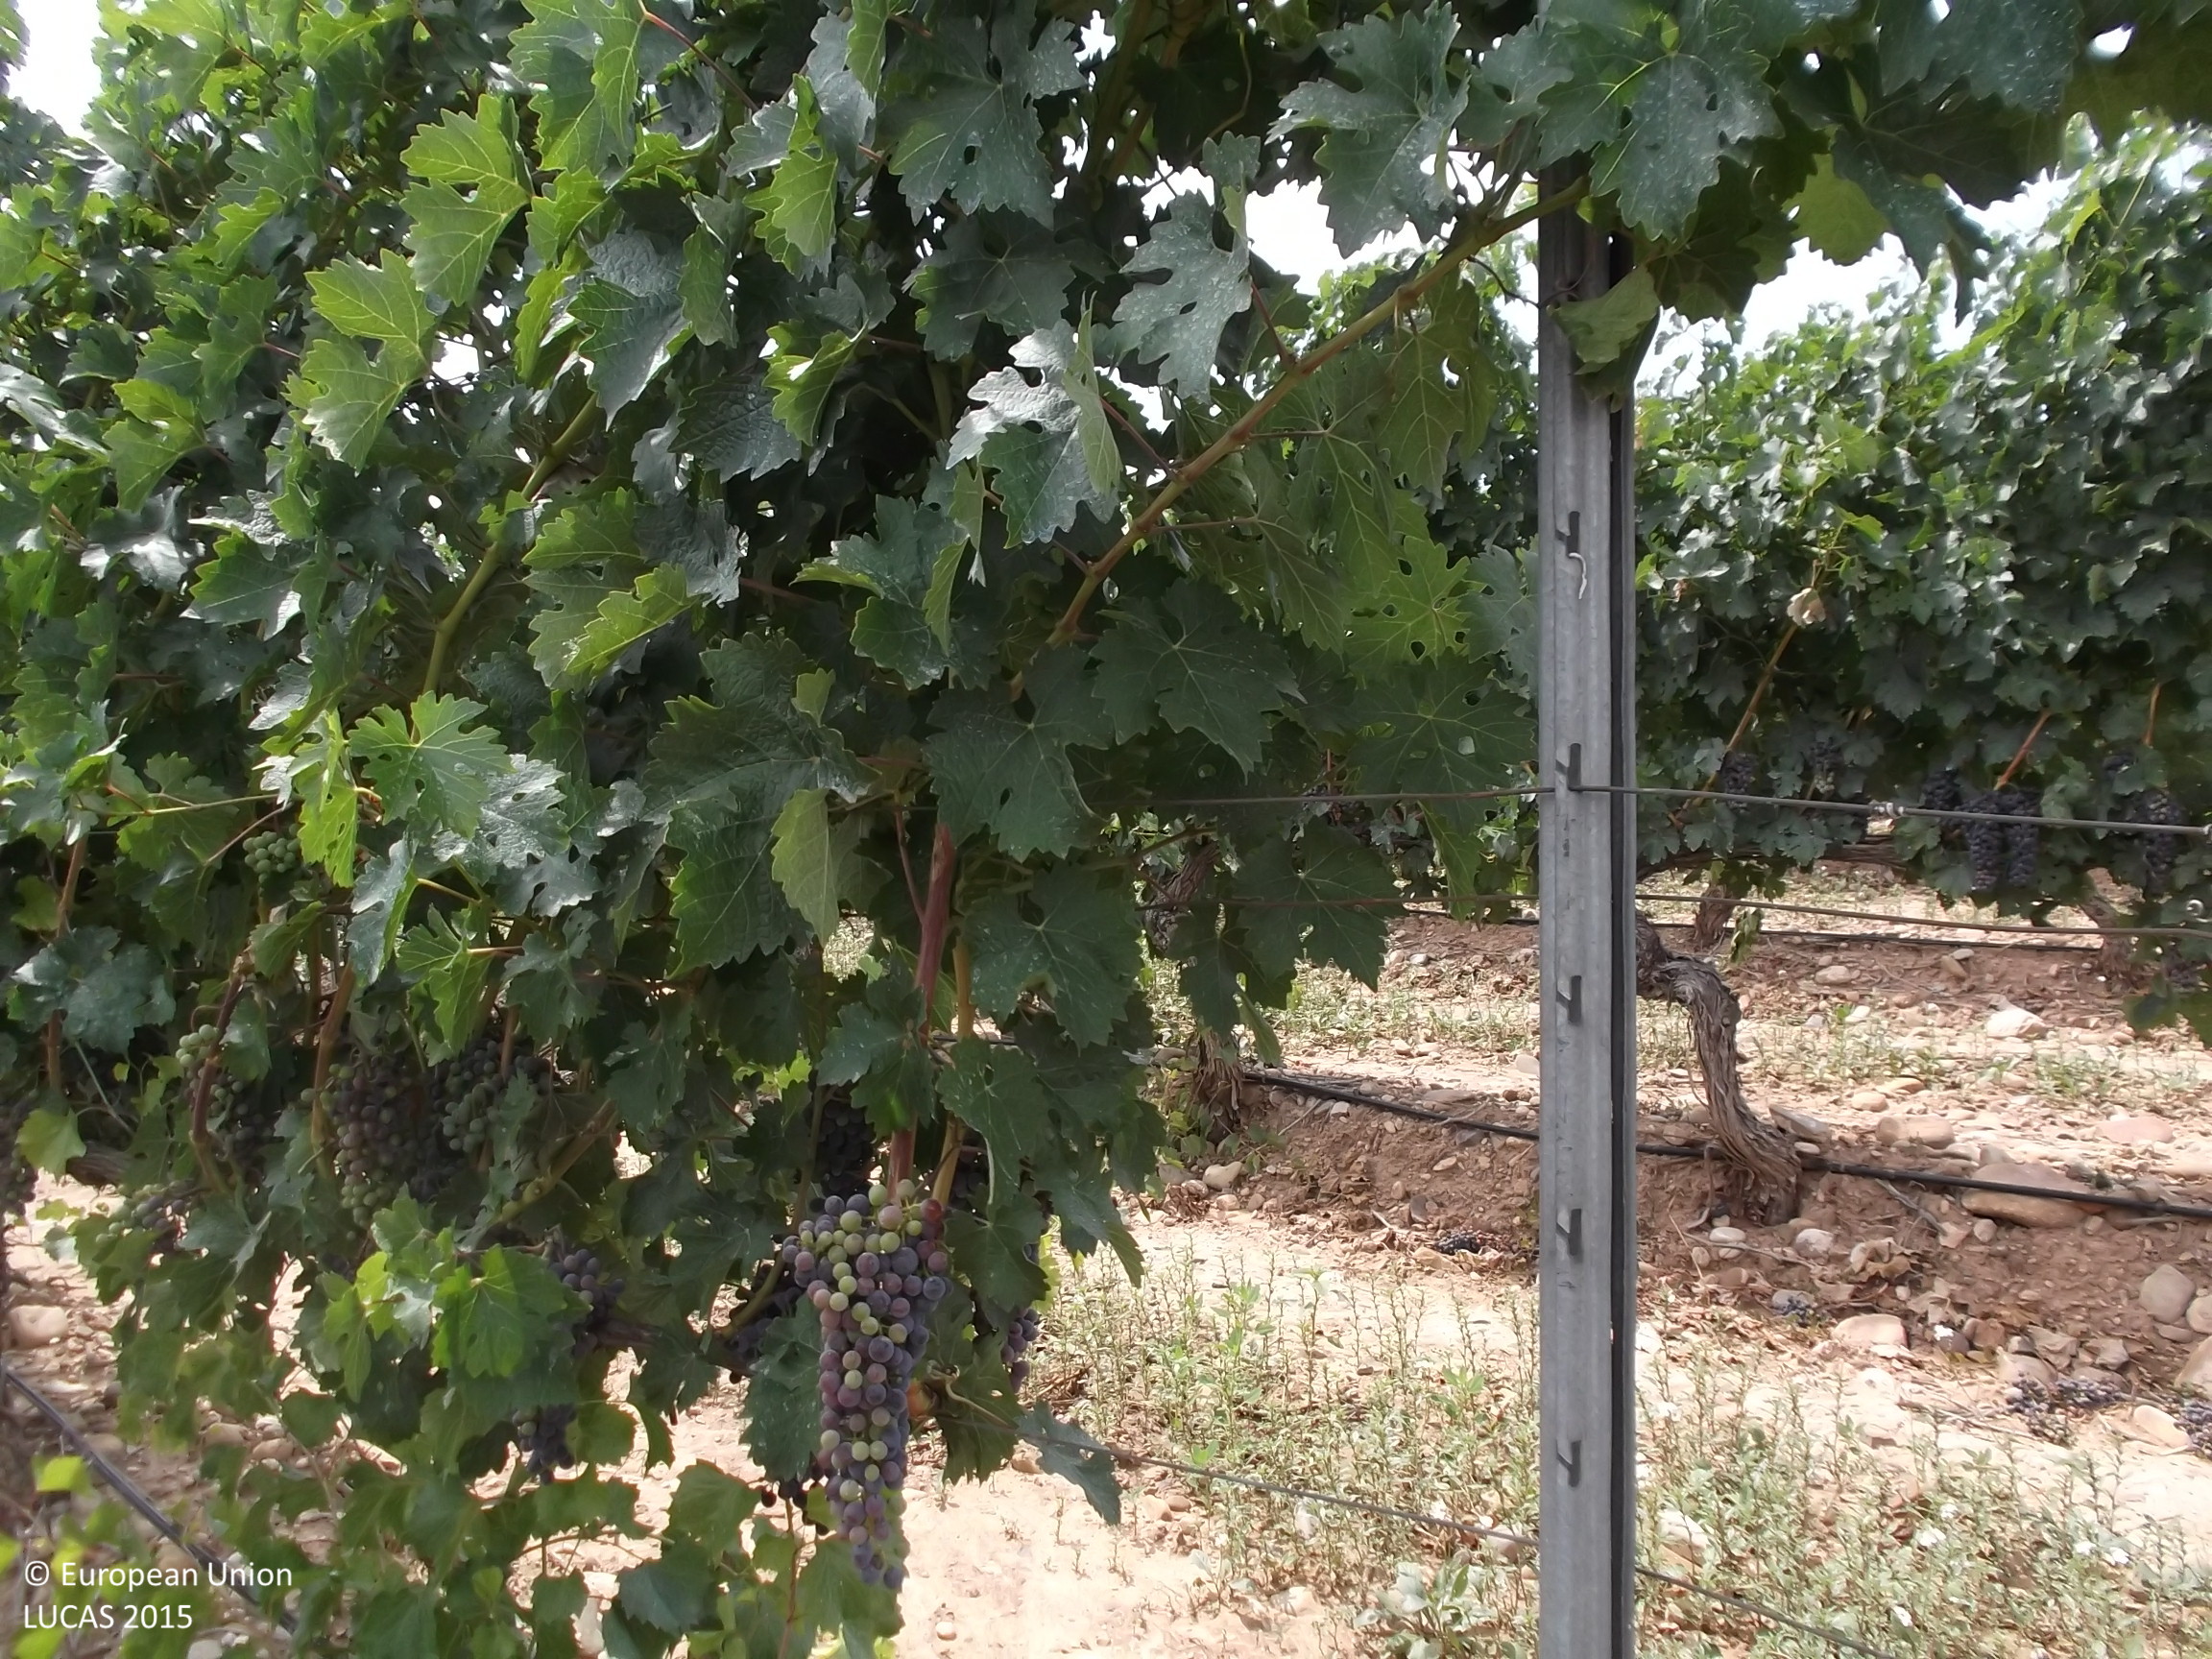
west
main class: Cropland
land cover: Vineyards
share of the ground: 10 - 25 %
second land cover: Other bare soil
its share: > 75 %
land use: Agriculture (excluding fallow land and kitchen gardens)
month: August
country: ES
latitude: 42.4293
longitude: -2.1595
